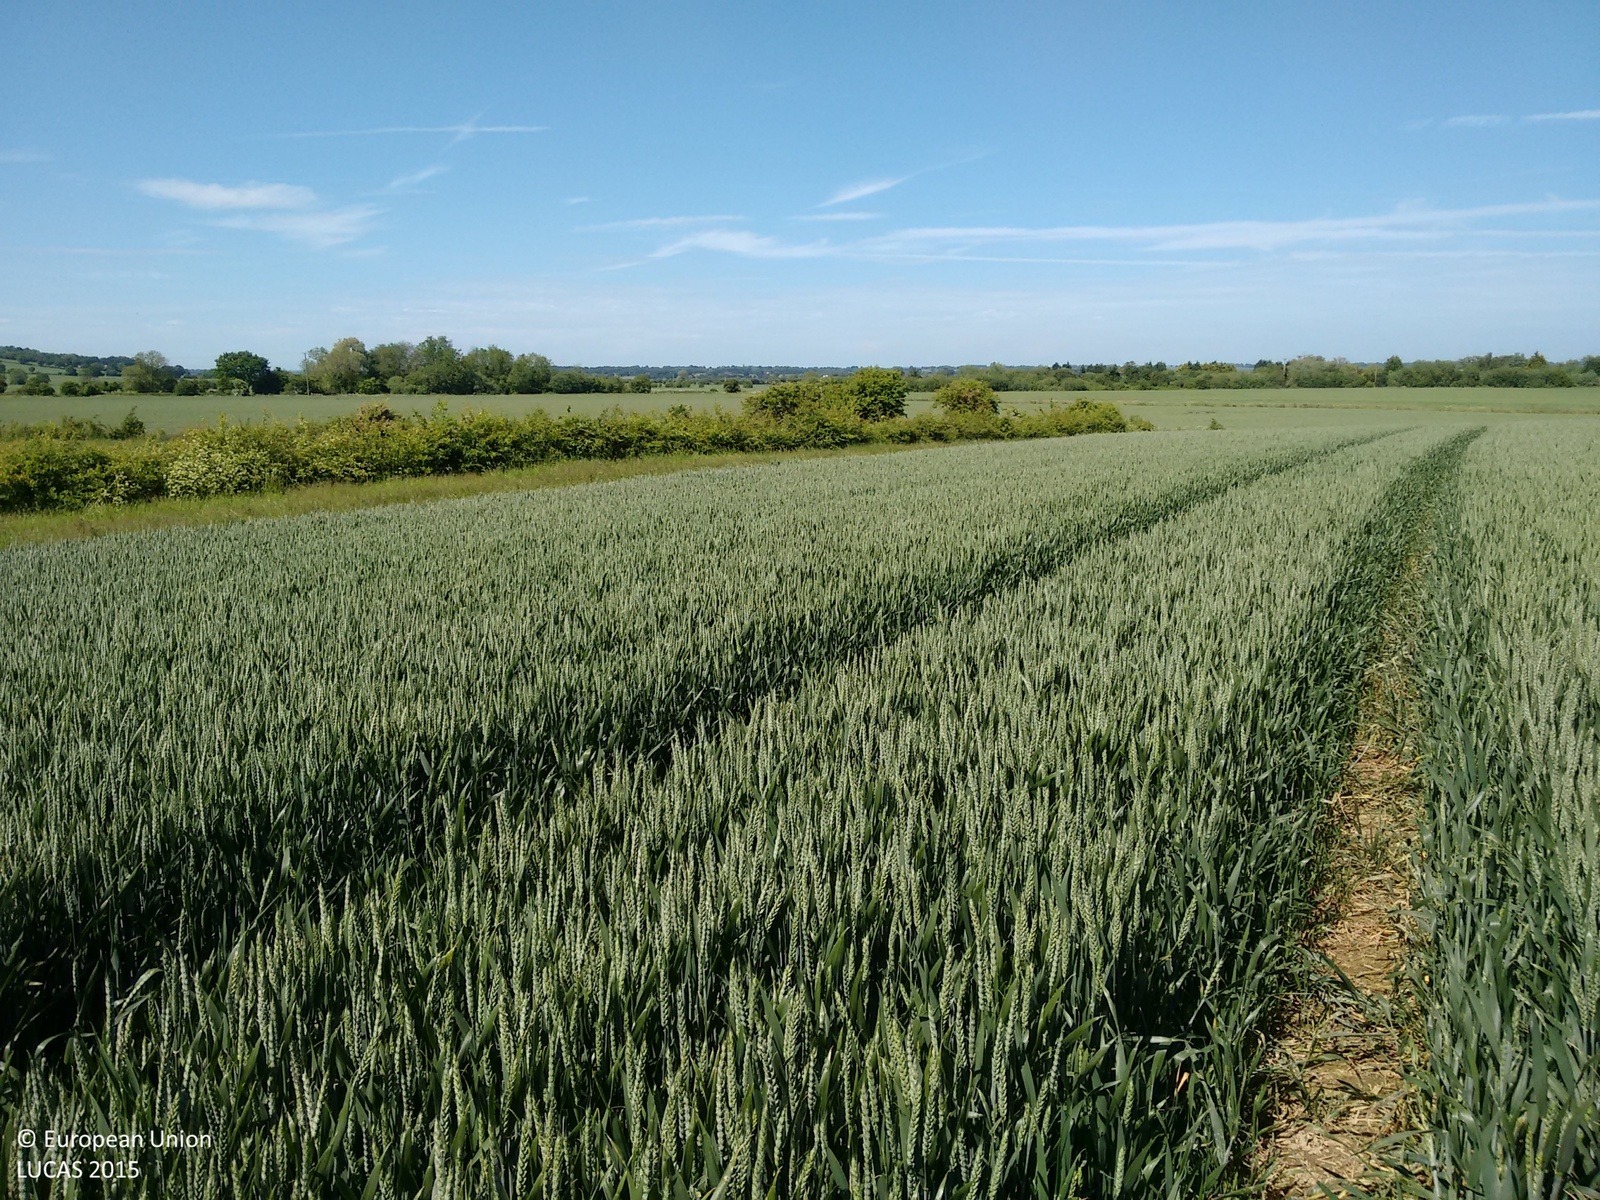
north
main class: Cropland
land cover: Common wheat
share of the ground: > 75 %
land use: Agriculture (excluding fallow land and kitchen gardens)
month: June
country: GB
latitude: 51.0381
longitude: 0.7473
